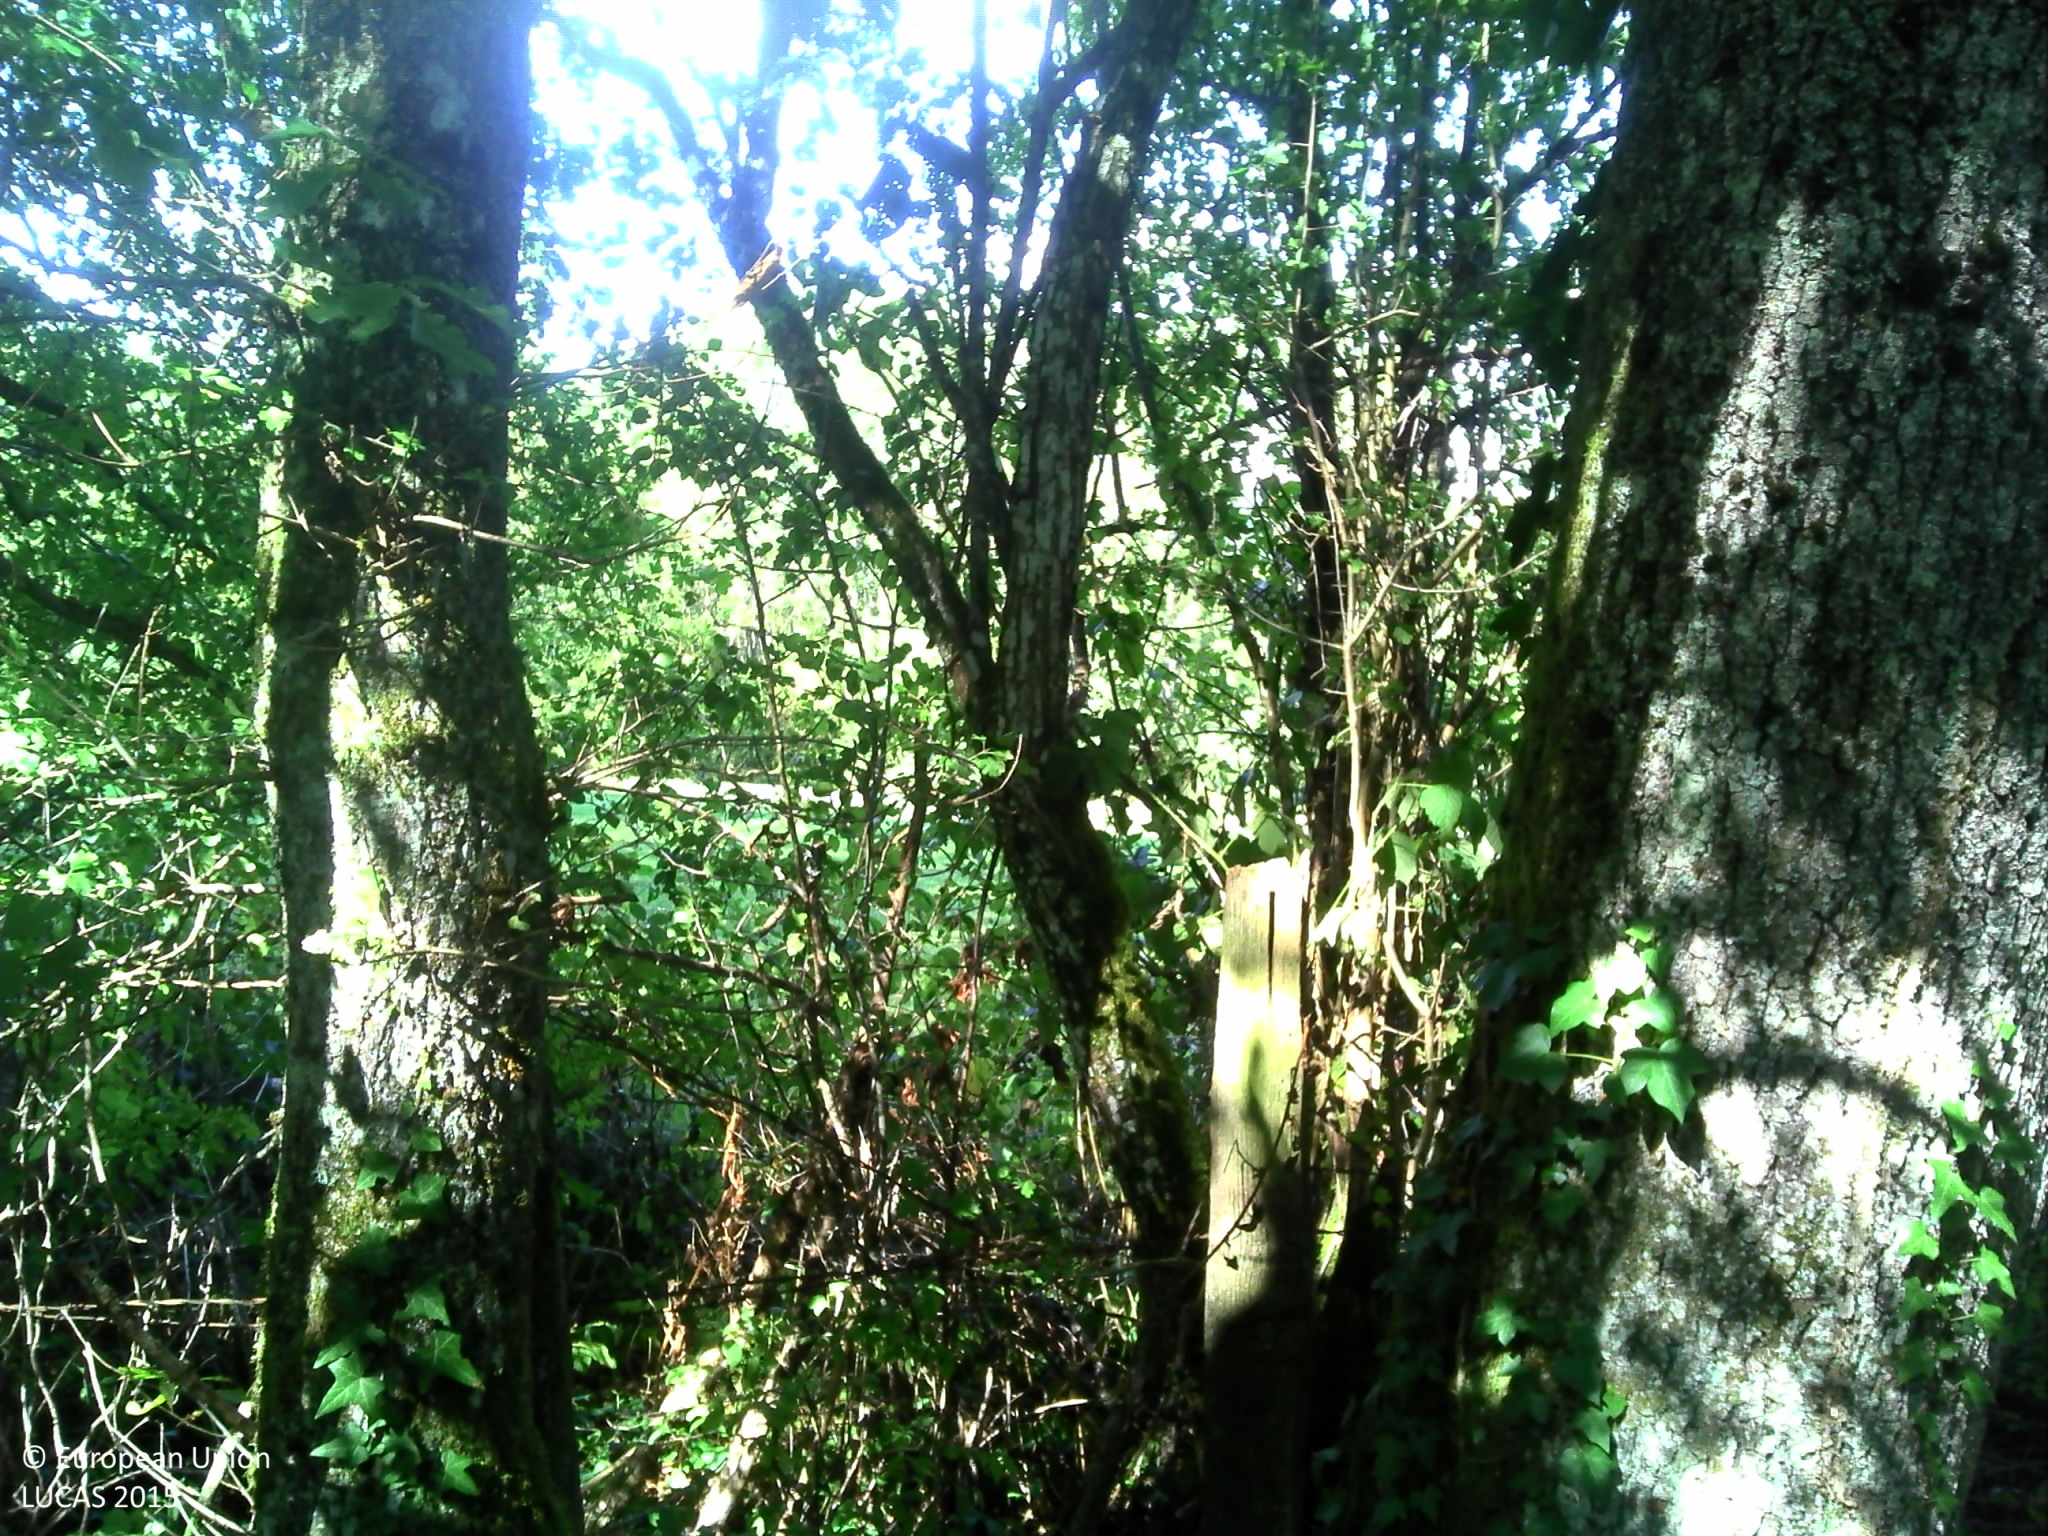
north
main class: Woodland
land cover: Broadleaved woodland
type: mesophytic deciduous forest
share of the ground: > 75 %
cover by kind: broadleaved forest trees 85 %, herbaceous plants 10 %
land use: Forestry
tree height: > 5 m
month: September
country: FR
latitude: 47.5231
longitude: 6.6150
